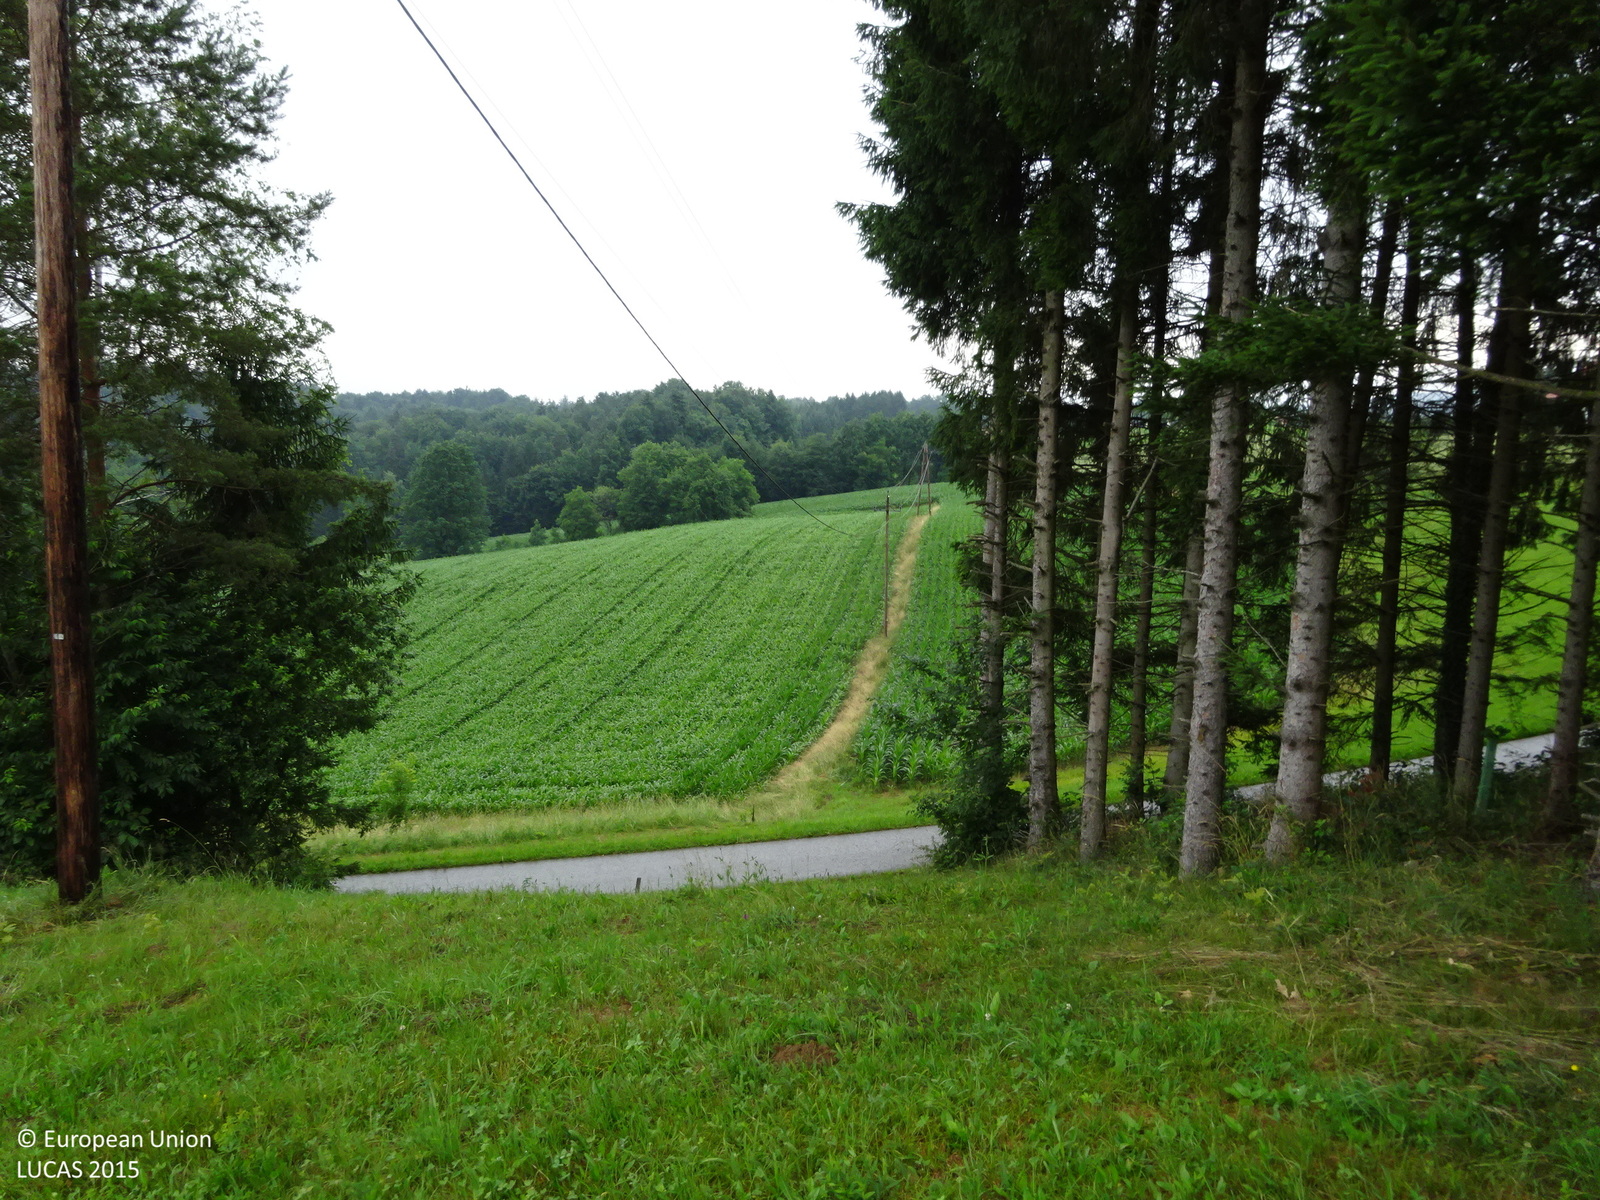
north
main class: Grassland
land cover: Grassland without tree/shrub cover
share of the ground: > 75 %
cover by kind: herbaceous plants 100 %
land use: Agriculture (excluding fallow land and kitchen gardens)
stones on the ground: < 10 %
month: June
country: AT
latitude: 46.7393
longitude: 15.3781
